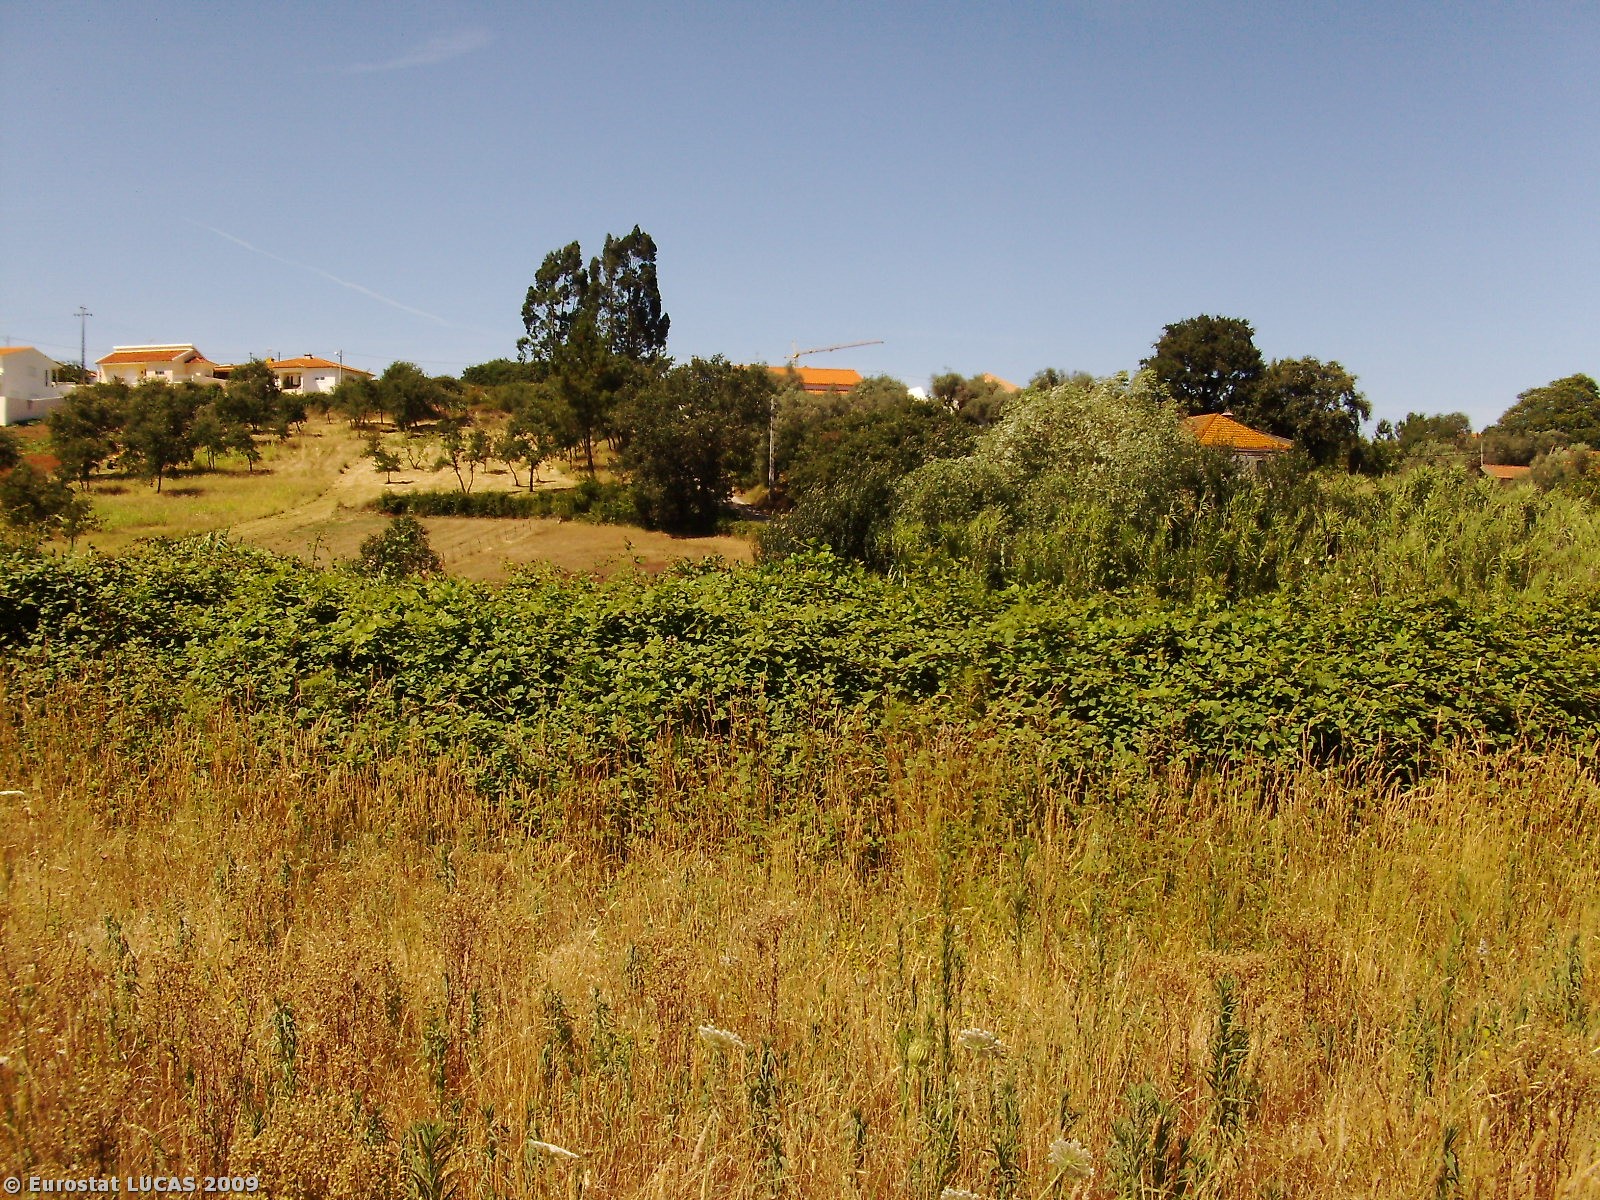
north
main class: Grassland
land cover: Spontaneously vegetated surfaces
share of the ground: > 75 %
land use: Fallow land
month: July
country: PT
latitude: 39.6769
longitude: -8.8683
